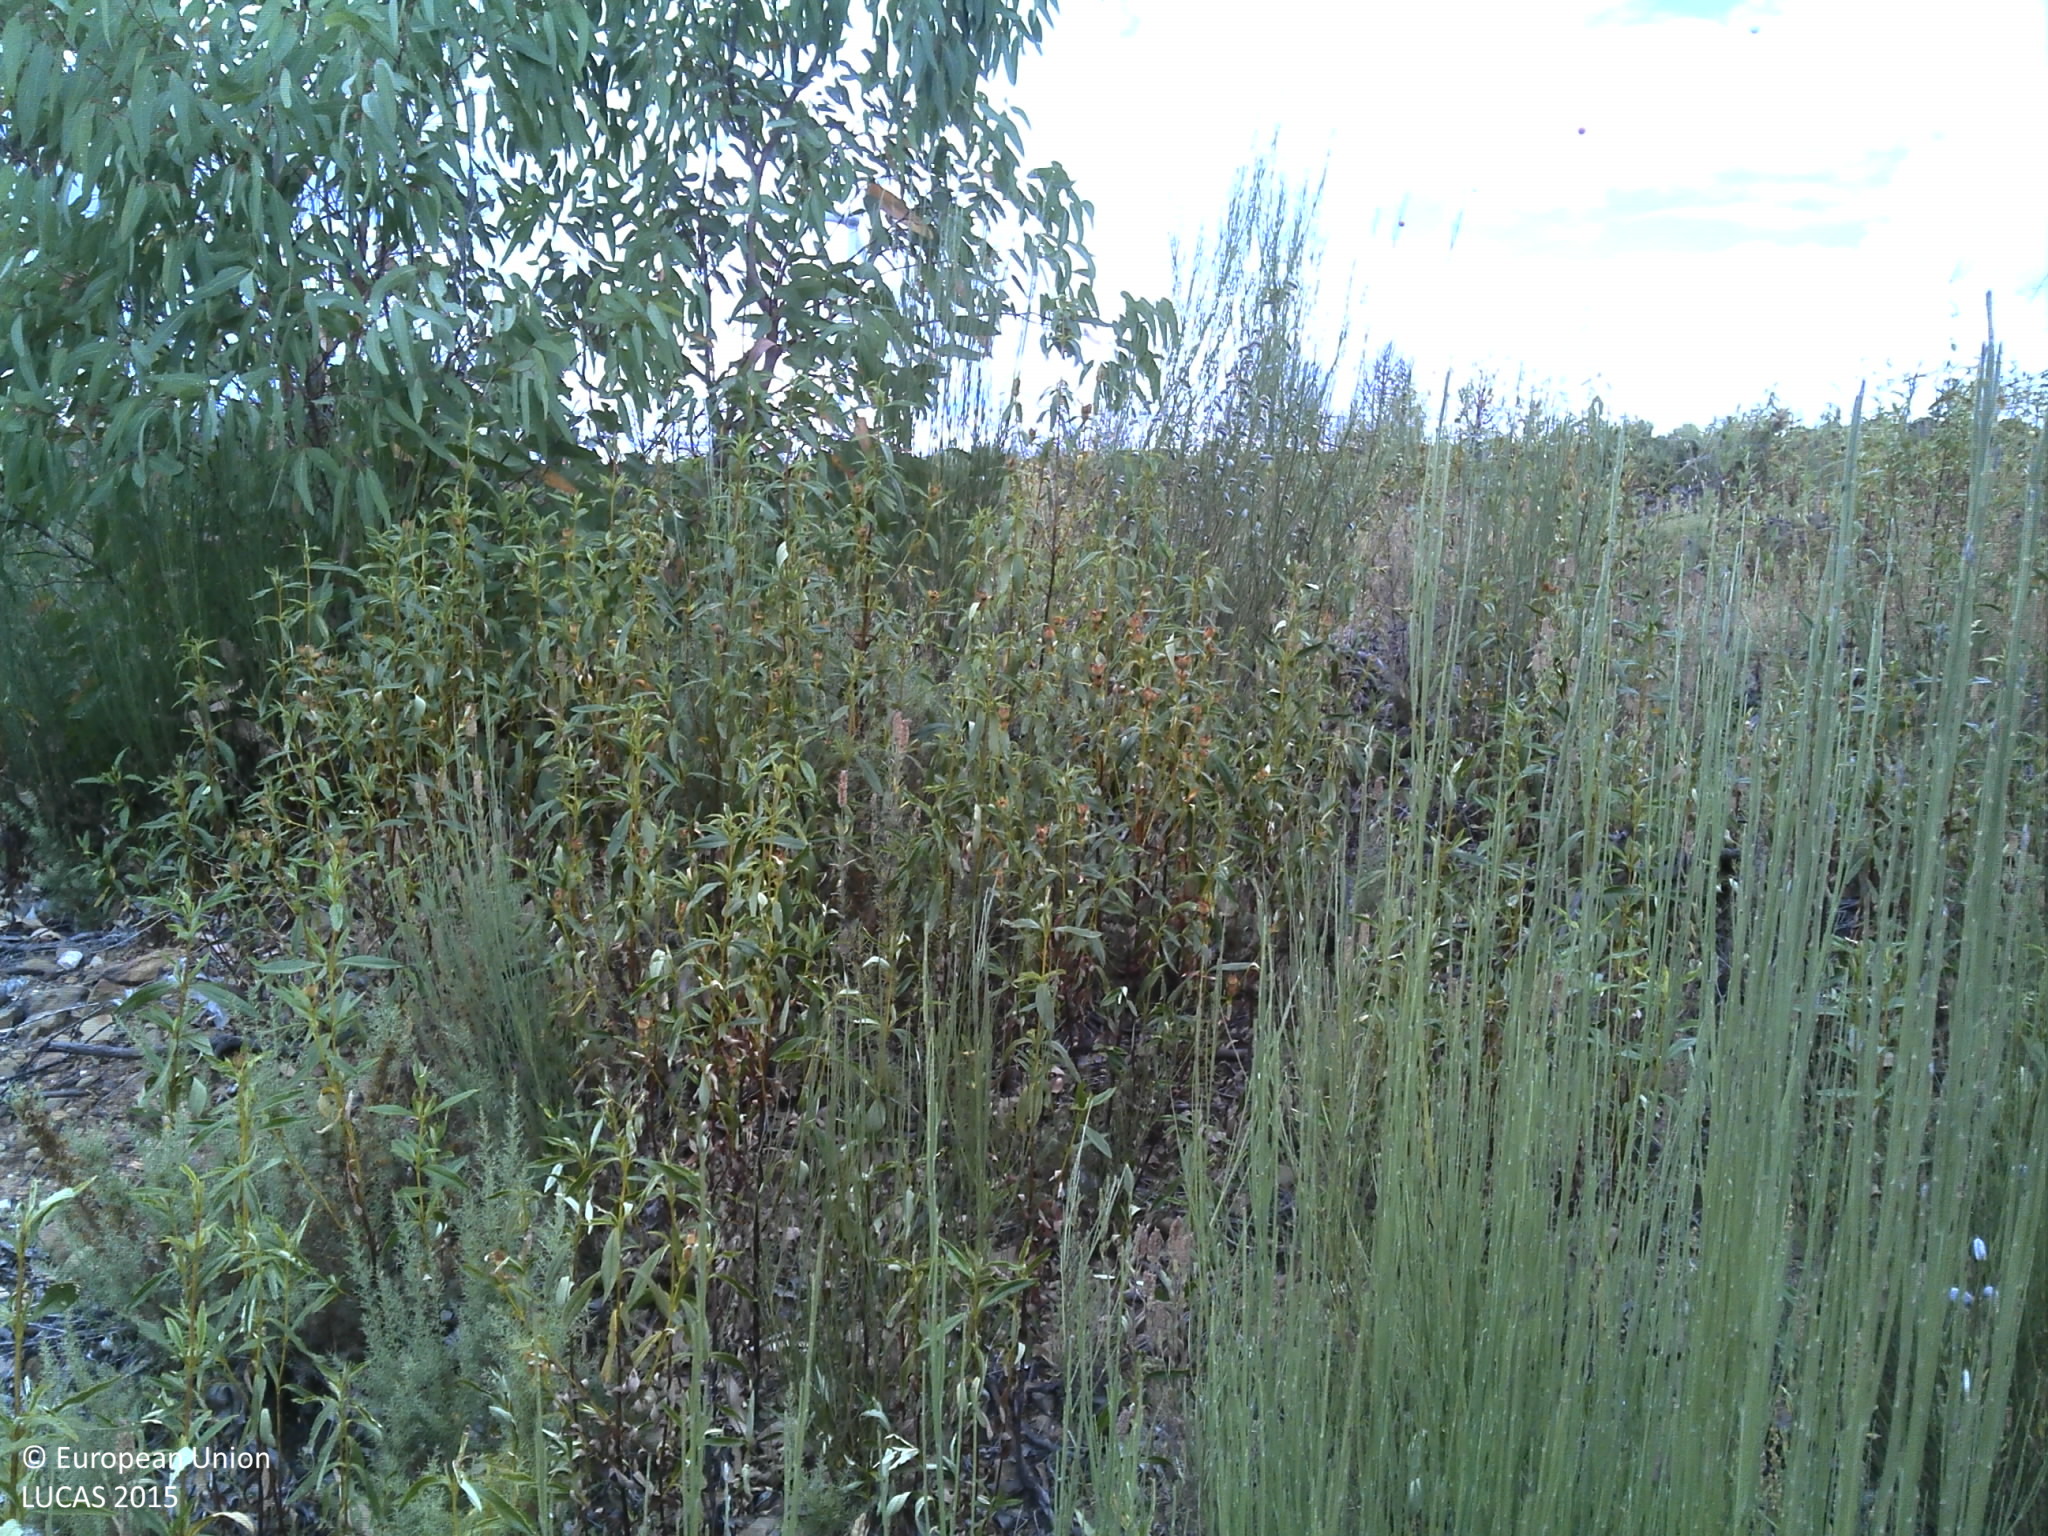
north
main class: Woodland
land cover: Broadleaved woodland
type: exotic forest
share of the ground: 10 - 25 %
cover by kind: shrubs 45 %, broadleaved forest trees 25 %, unconsolidated bare surface 20 %, herbaceous plants 10 %
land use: Forestry
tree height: < 5 m
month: June
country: PT
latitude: 37.3026
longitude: -7.8495
